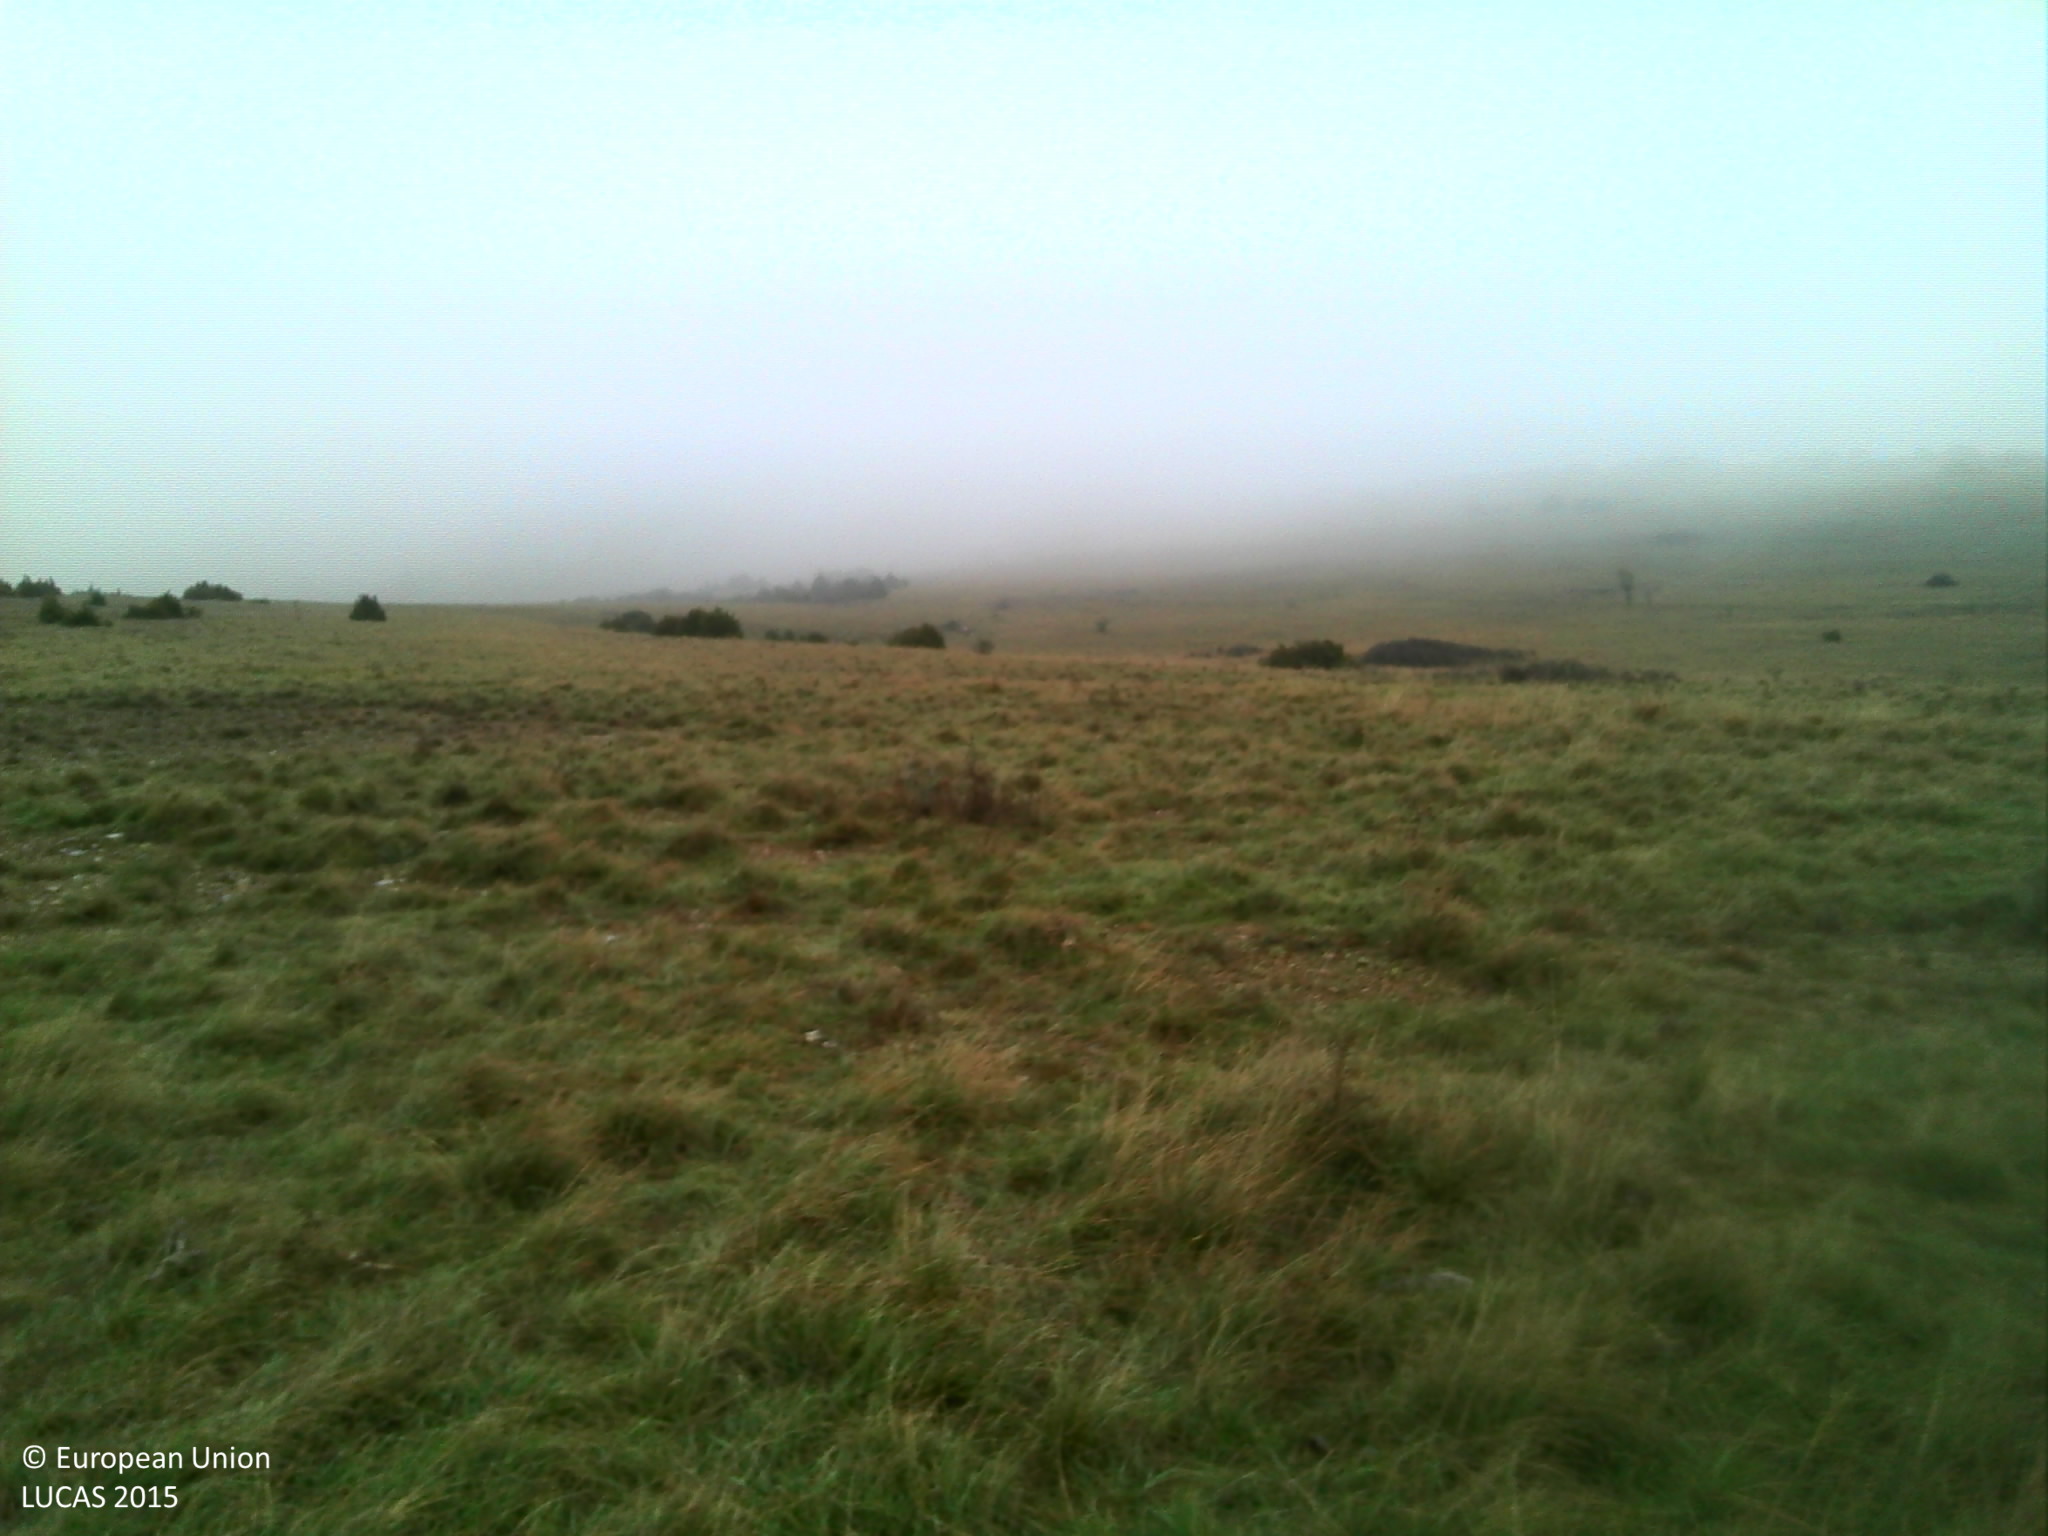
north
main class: Grassland
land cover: Grassland without tree/shrub cover
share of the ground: > 75 %
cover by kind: herbaceous plants 100 %
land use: Agriculture (excluding fallow land and kitchen gardens)
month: November
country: FR
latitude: 44.0290
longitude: 3.0815
